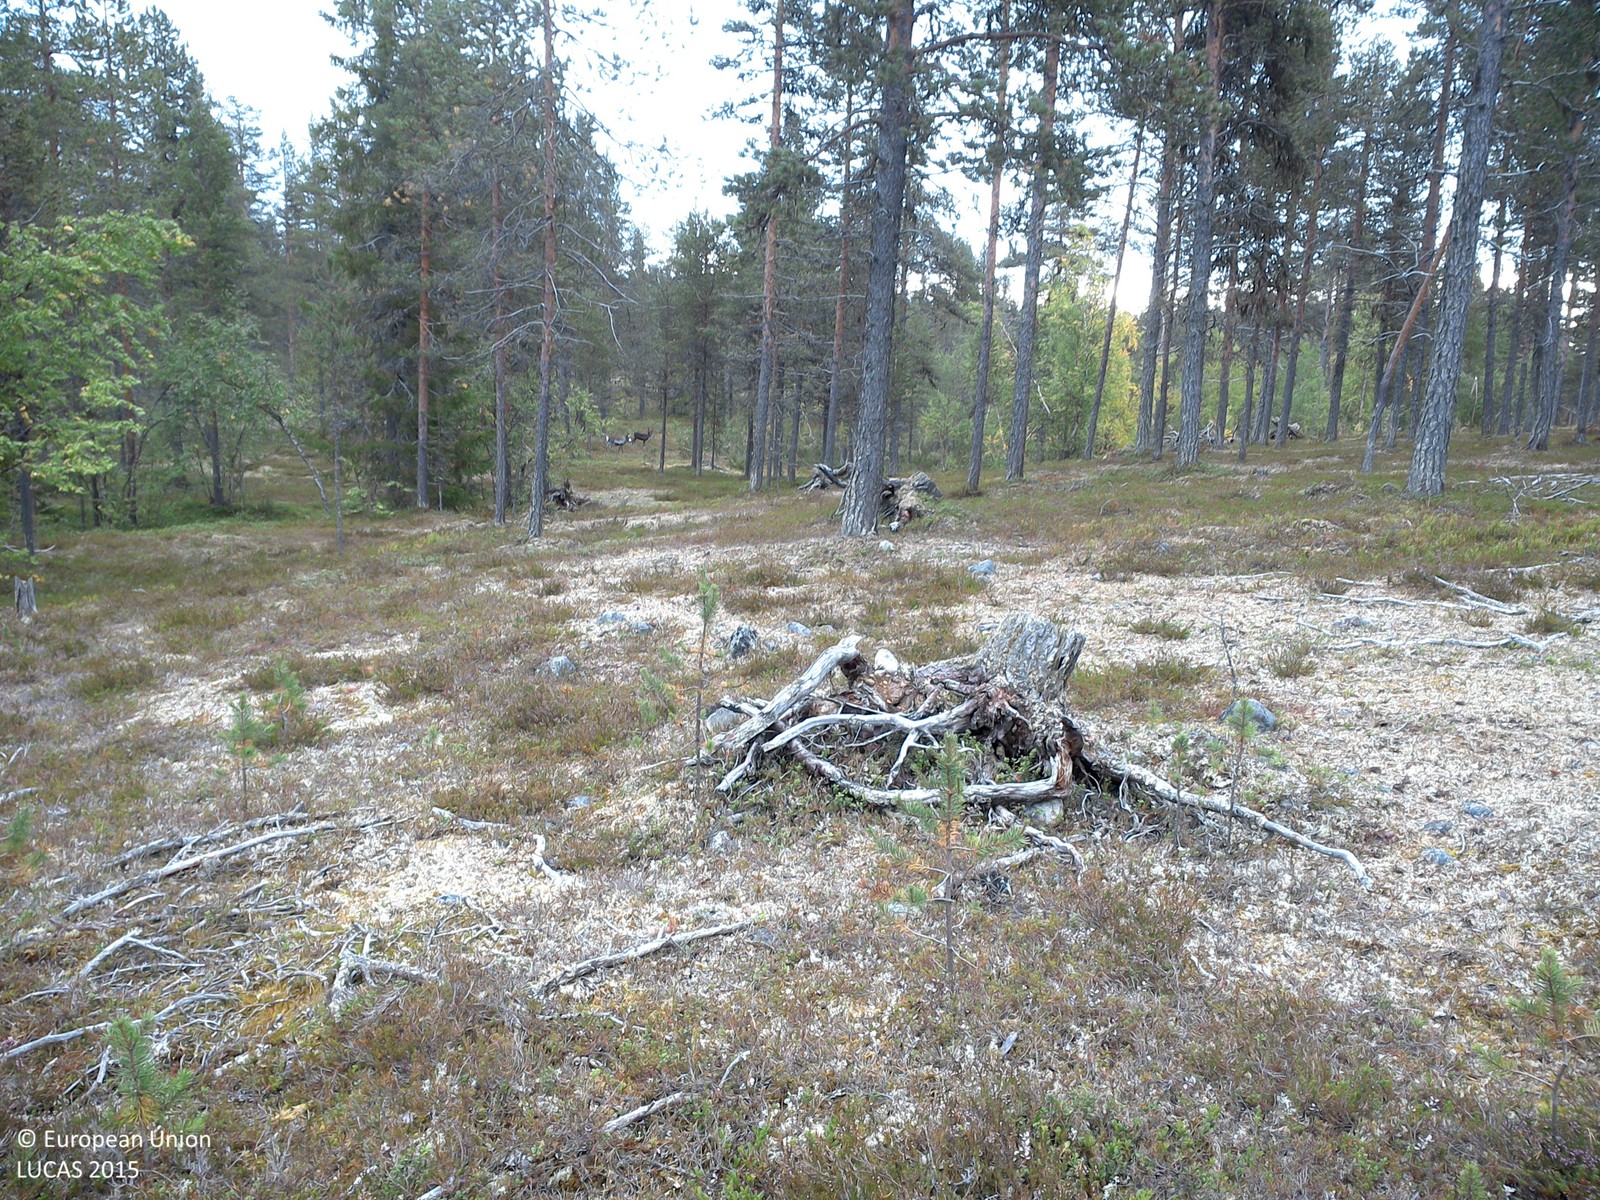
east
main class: Woodland
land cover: Pine dominated coniferous woodland
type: boreal forest
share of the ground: 10 - 25 %
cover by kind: shrubs 50 %, lichens and mosses 35 %, coniferous forest trees 15 %
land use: Forestry
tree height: > 5 m
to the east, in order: Pine dominated coniferous woodland; Ditches and canals; Paved roads, cycling and walking lanes; Pine dominated coniferous woodland; Broadleaved woodland
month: August
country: SE
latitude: 67.9479
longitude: 23.2048
